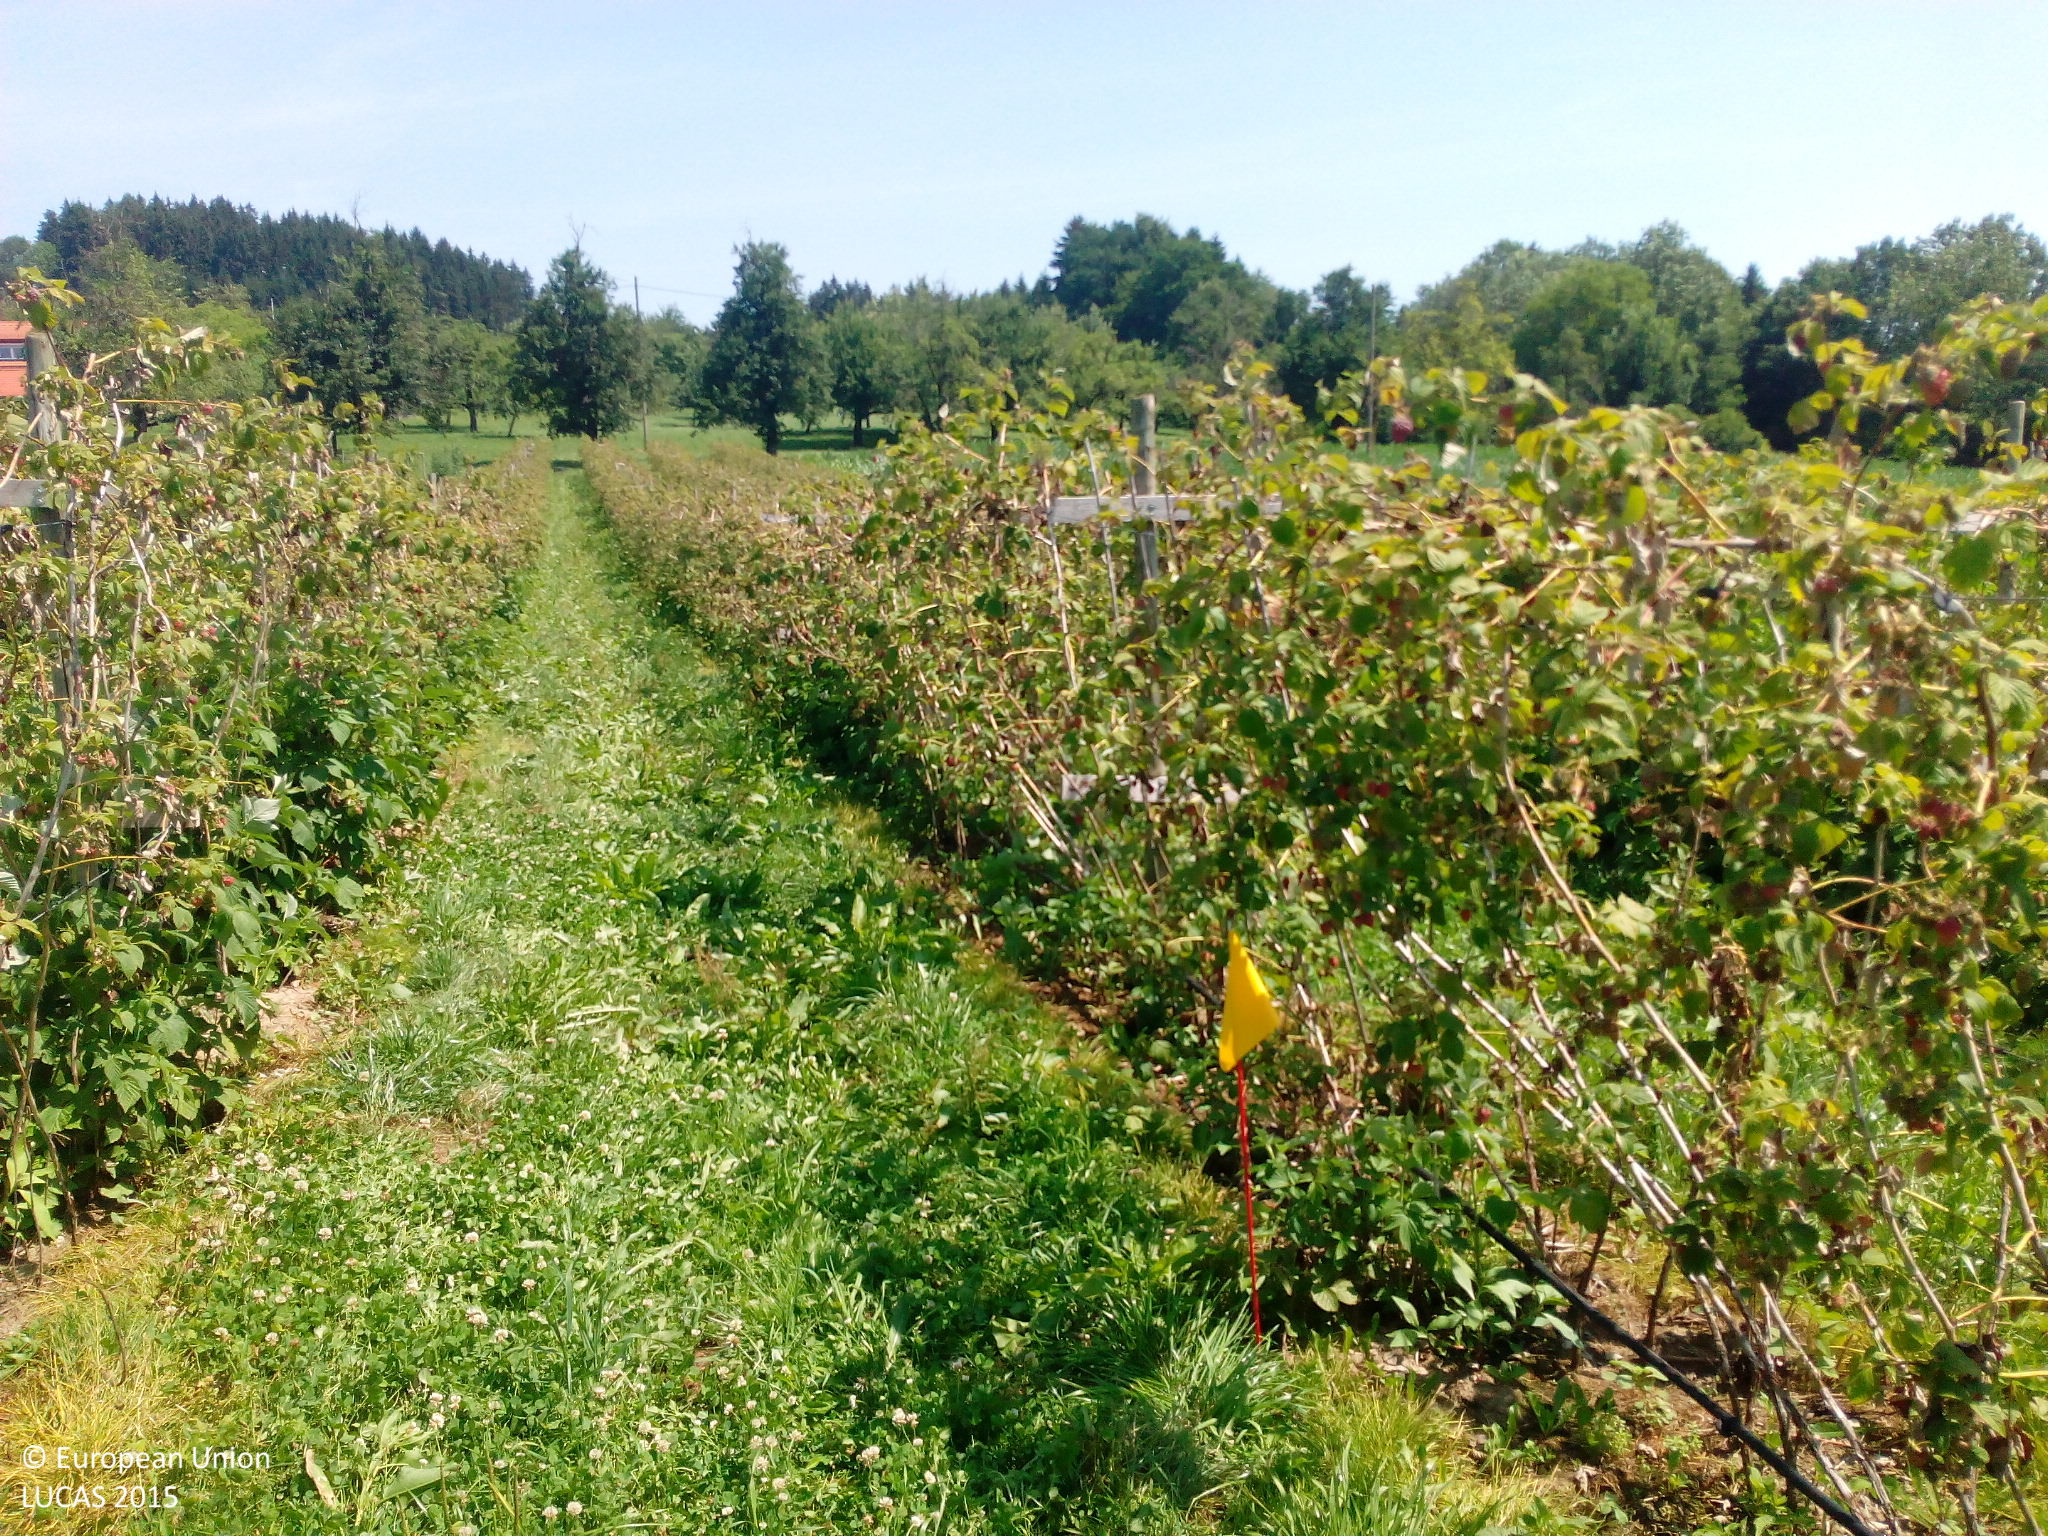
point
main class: Cropland
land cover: Other fruit trees and berries
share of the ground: 25 - 50 %
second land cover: Grassland without tree/shrub cover
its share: 50 - 75 %
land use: Agriculture (excluding fallow land and kitchen gardens)
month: July
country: DE
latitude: 47.7721
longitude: 9.4266
